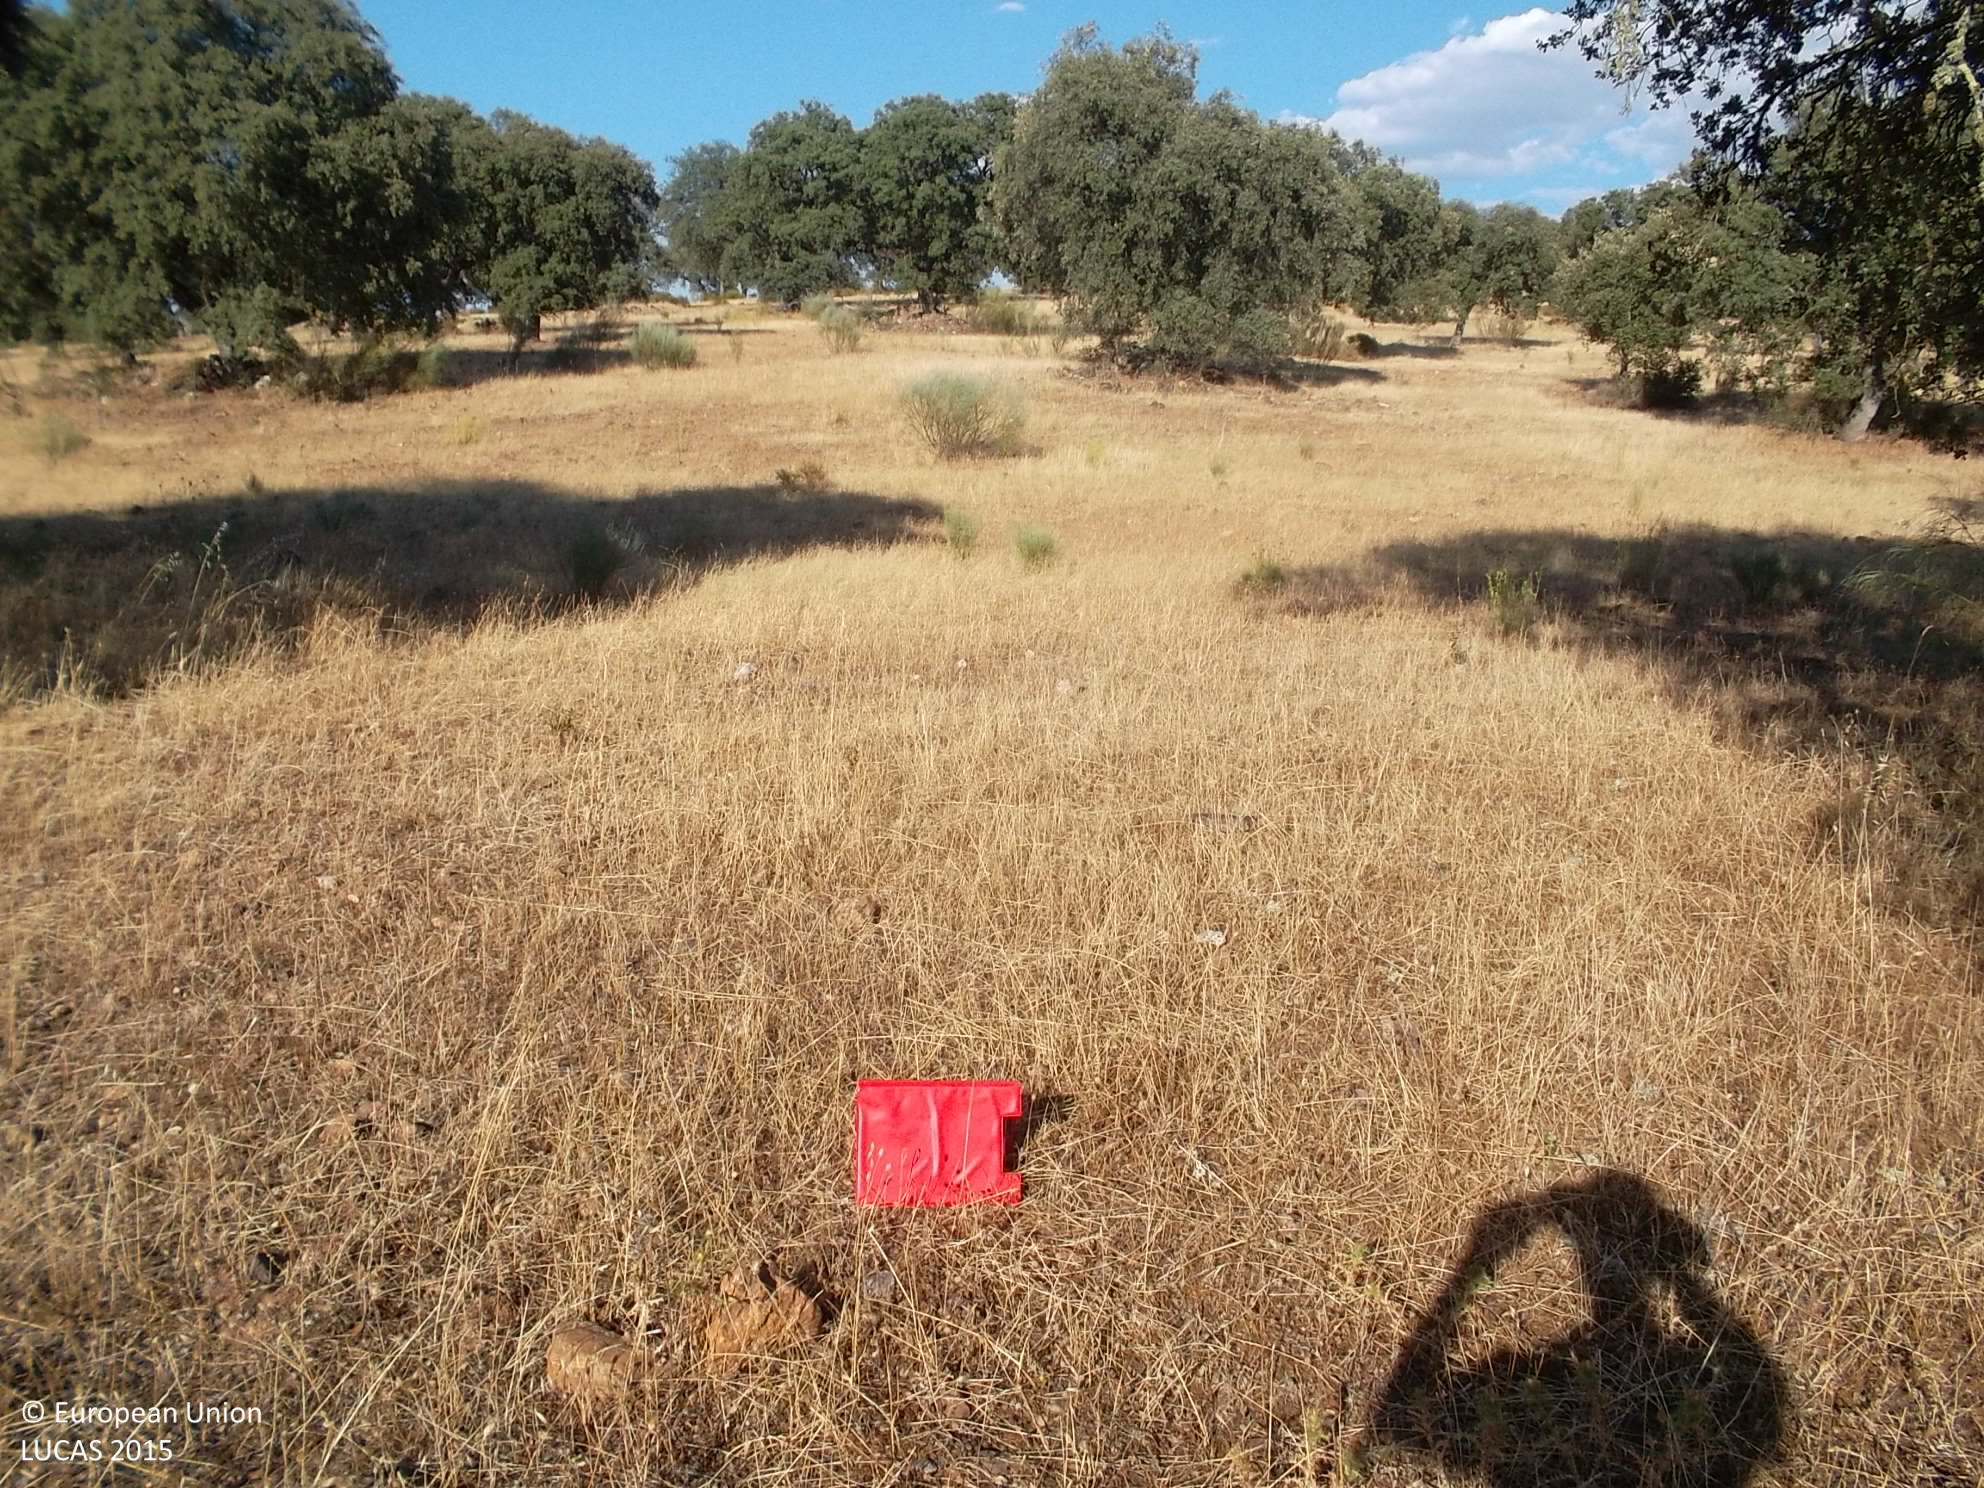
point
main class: Woodland
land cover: Broadleaved woodland
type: broadleaved evergreen forest
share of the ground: 25 - 50 %
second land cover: Grassland without tree/shrub cover
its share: 25 - 50 %
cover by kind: herbaceous plants 60 %, broadleaved forest trees 40 %
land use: Forestry
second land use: Agriculture (excluding fallow land and kitchen gardens)
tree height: > 5 m
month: July
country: ES
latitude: 38.5198
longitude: -5.7883
